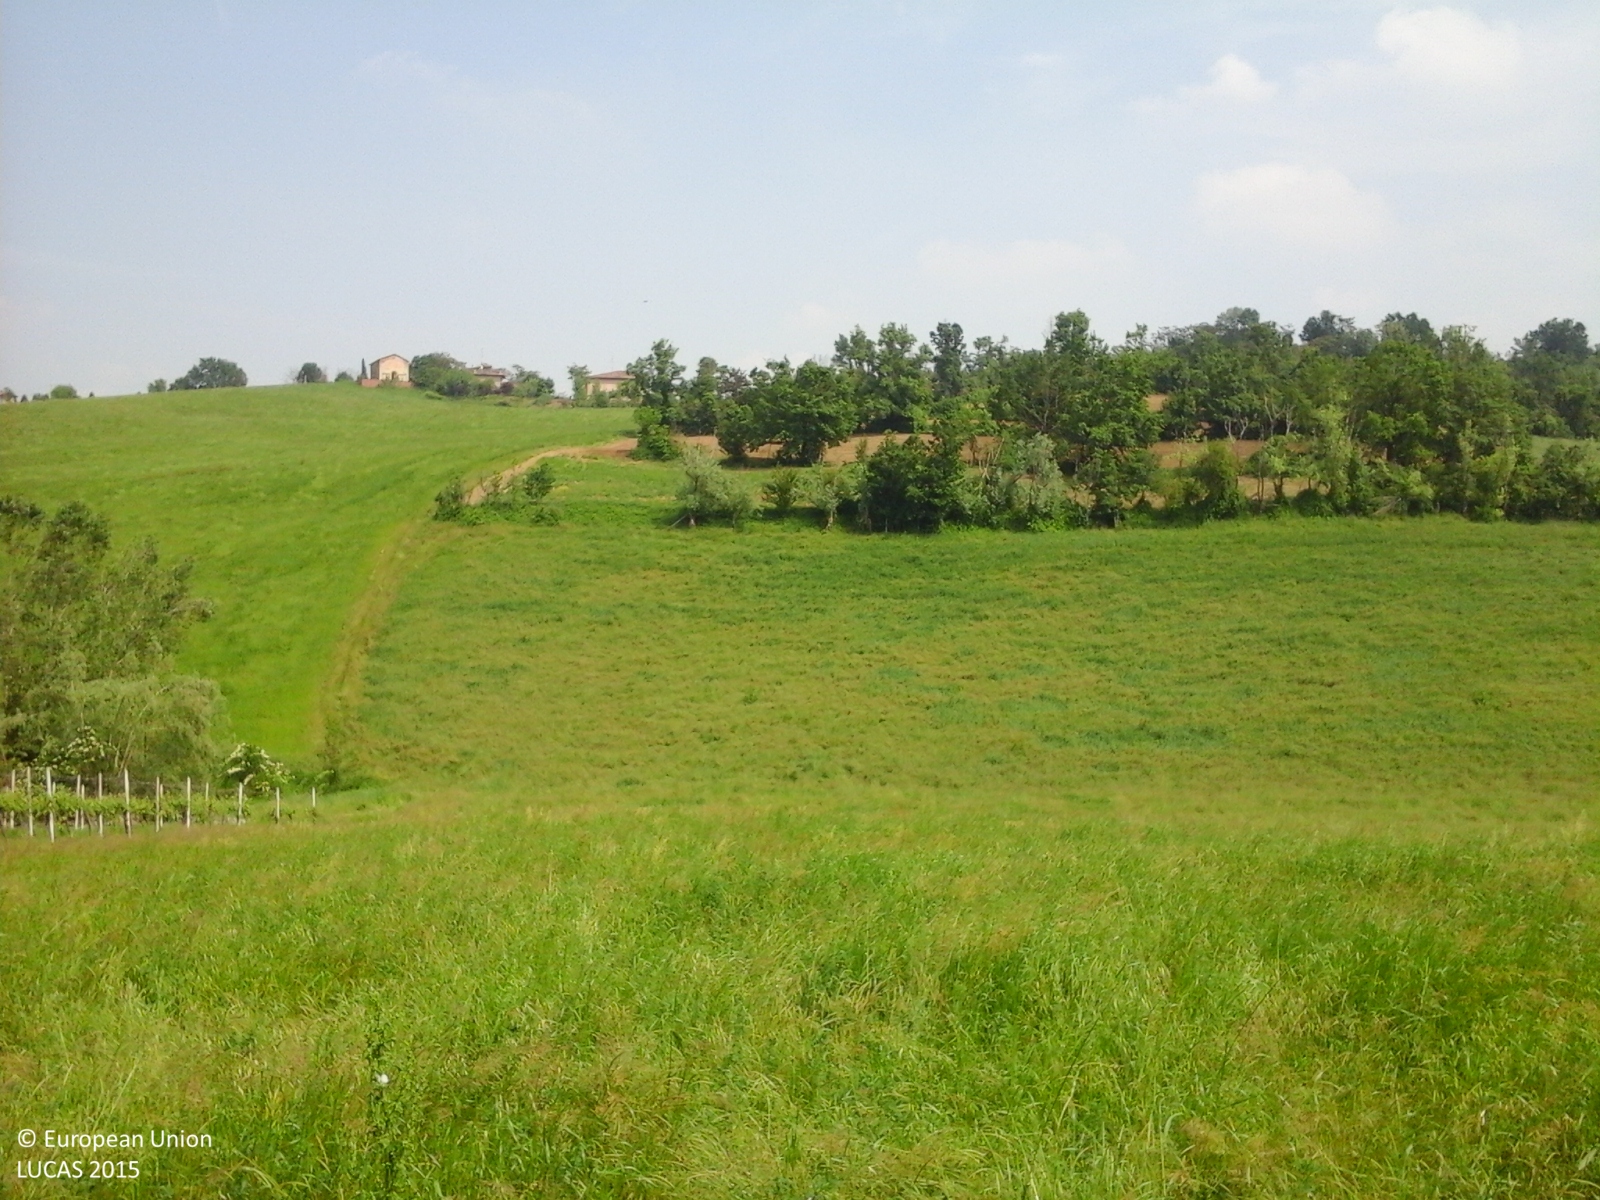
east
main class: Cropland
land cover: Lucerne
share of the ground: > 75 %
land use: Agriculture (excluding fallow land and kitchen gardens)
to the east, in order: Lucerne; Ditches and canals; Lucerne; Abandoned hedges; Spontaneously vegetated surfaces; Abandoned hedges; Other bare soil; Abandoned hedges
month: May
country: IT
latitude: 44.4908
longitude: 10.9159
